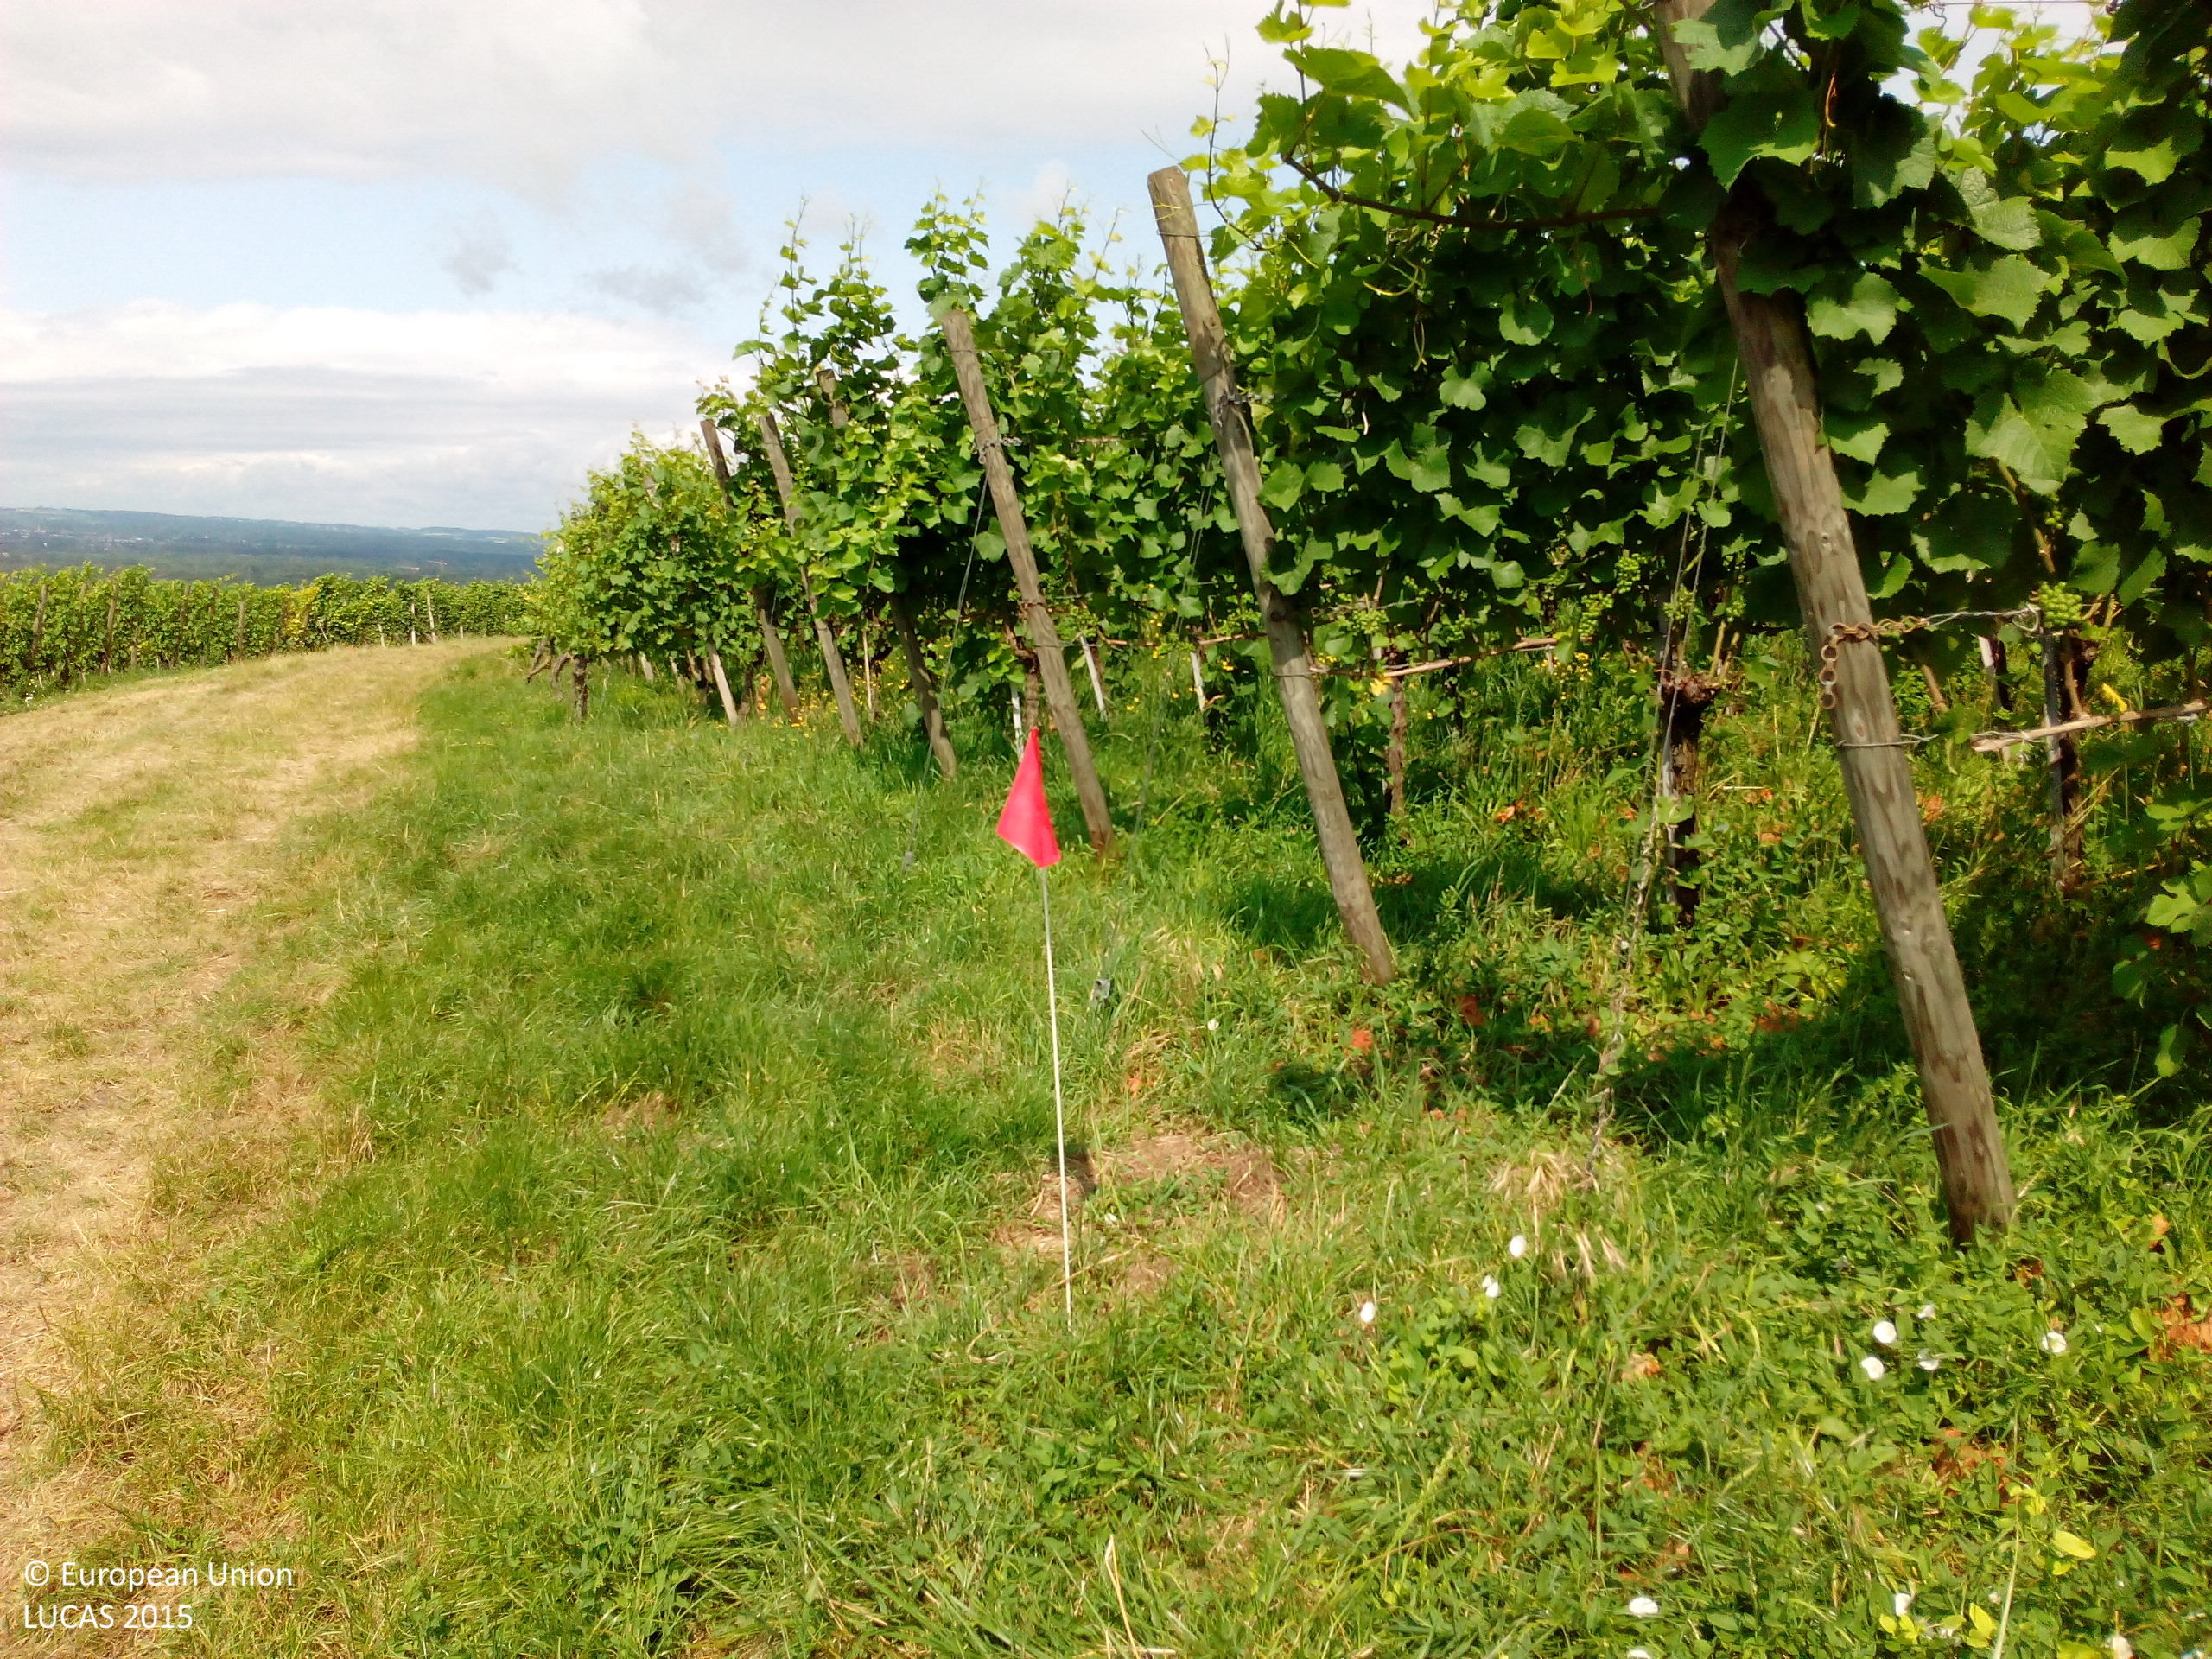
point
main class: Cropland
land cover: Vineyards
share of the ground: 25 - 50 %
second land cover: Grassland without tree/shrub cover
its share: 50 - 75 %
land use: Agriculture (excluding fallow land and kitchen gardens)
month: July
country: DE
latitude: 47.6217
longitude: 7.6198
